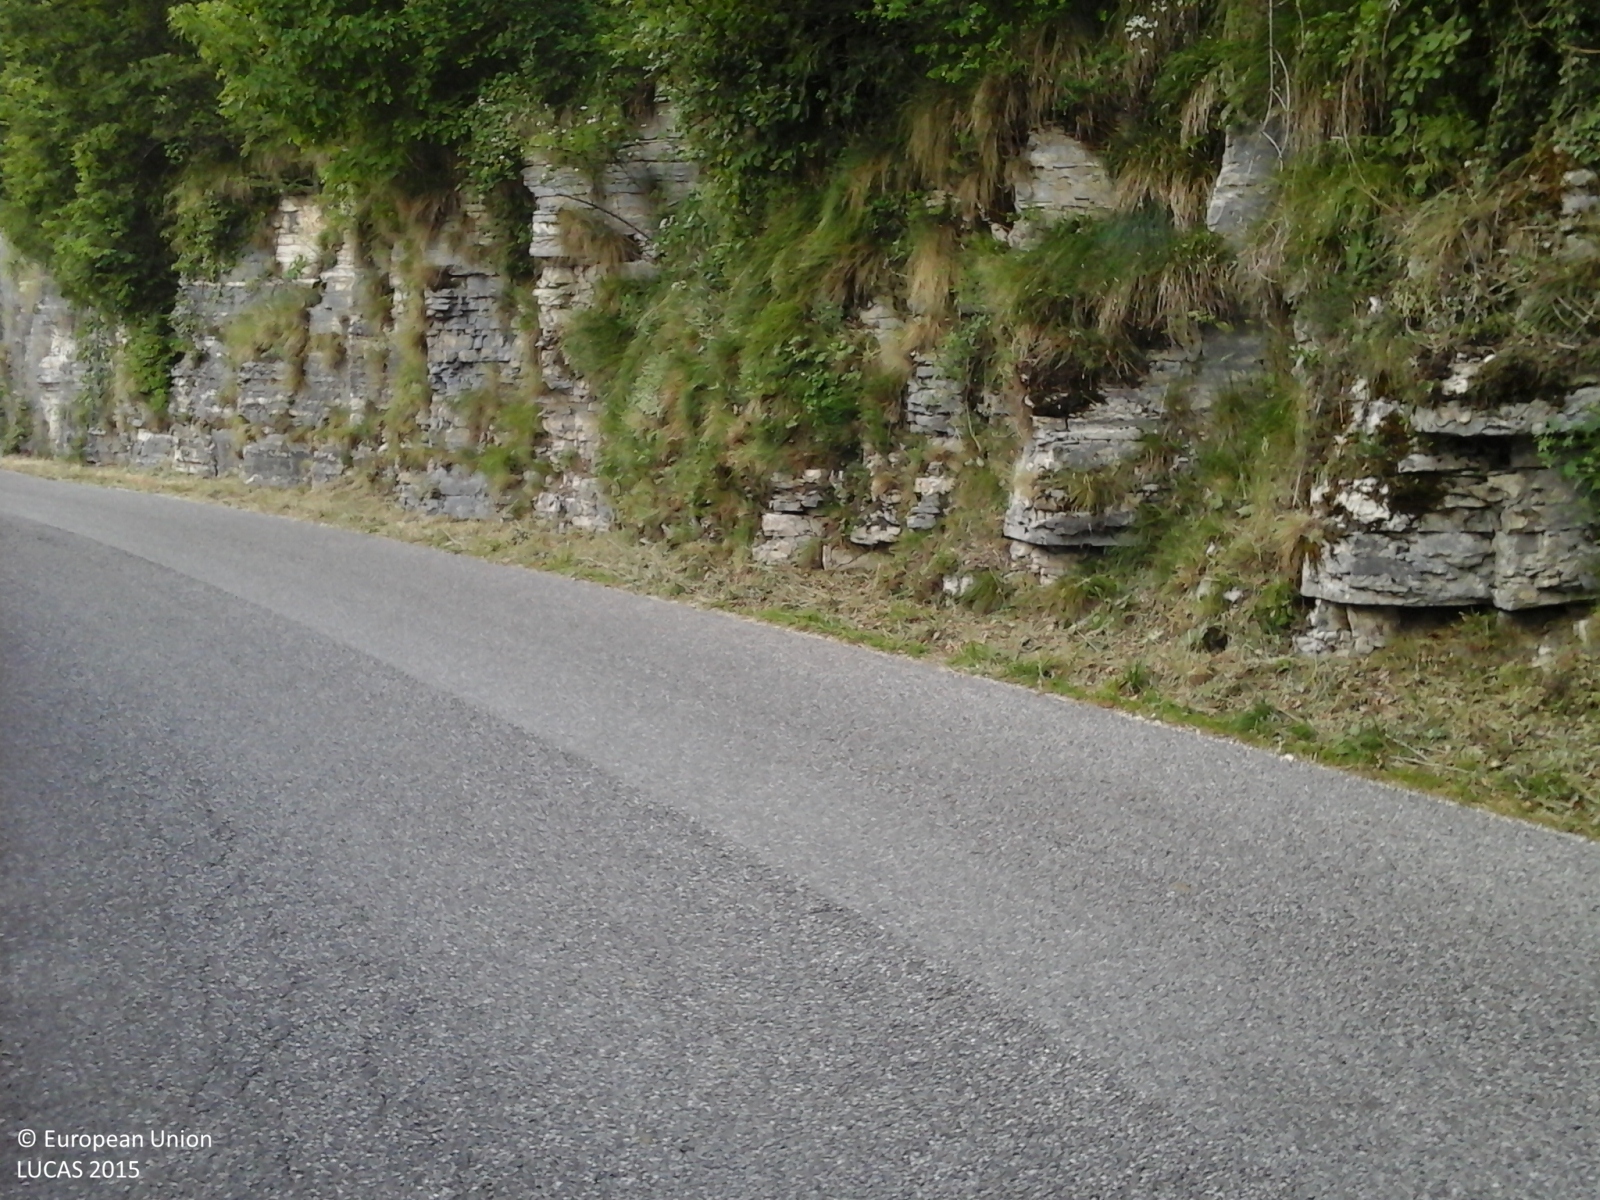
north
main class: Woodland
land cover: Broadleaved woodland
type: thermophilous deciduous forest
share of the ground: > 75 %
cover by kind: broadleaved forest trees 100 %
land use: Semi-natural and natural areas not in use
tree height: > 5 m
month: June
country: IT
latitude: 45.8326
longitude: 11.7354
